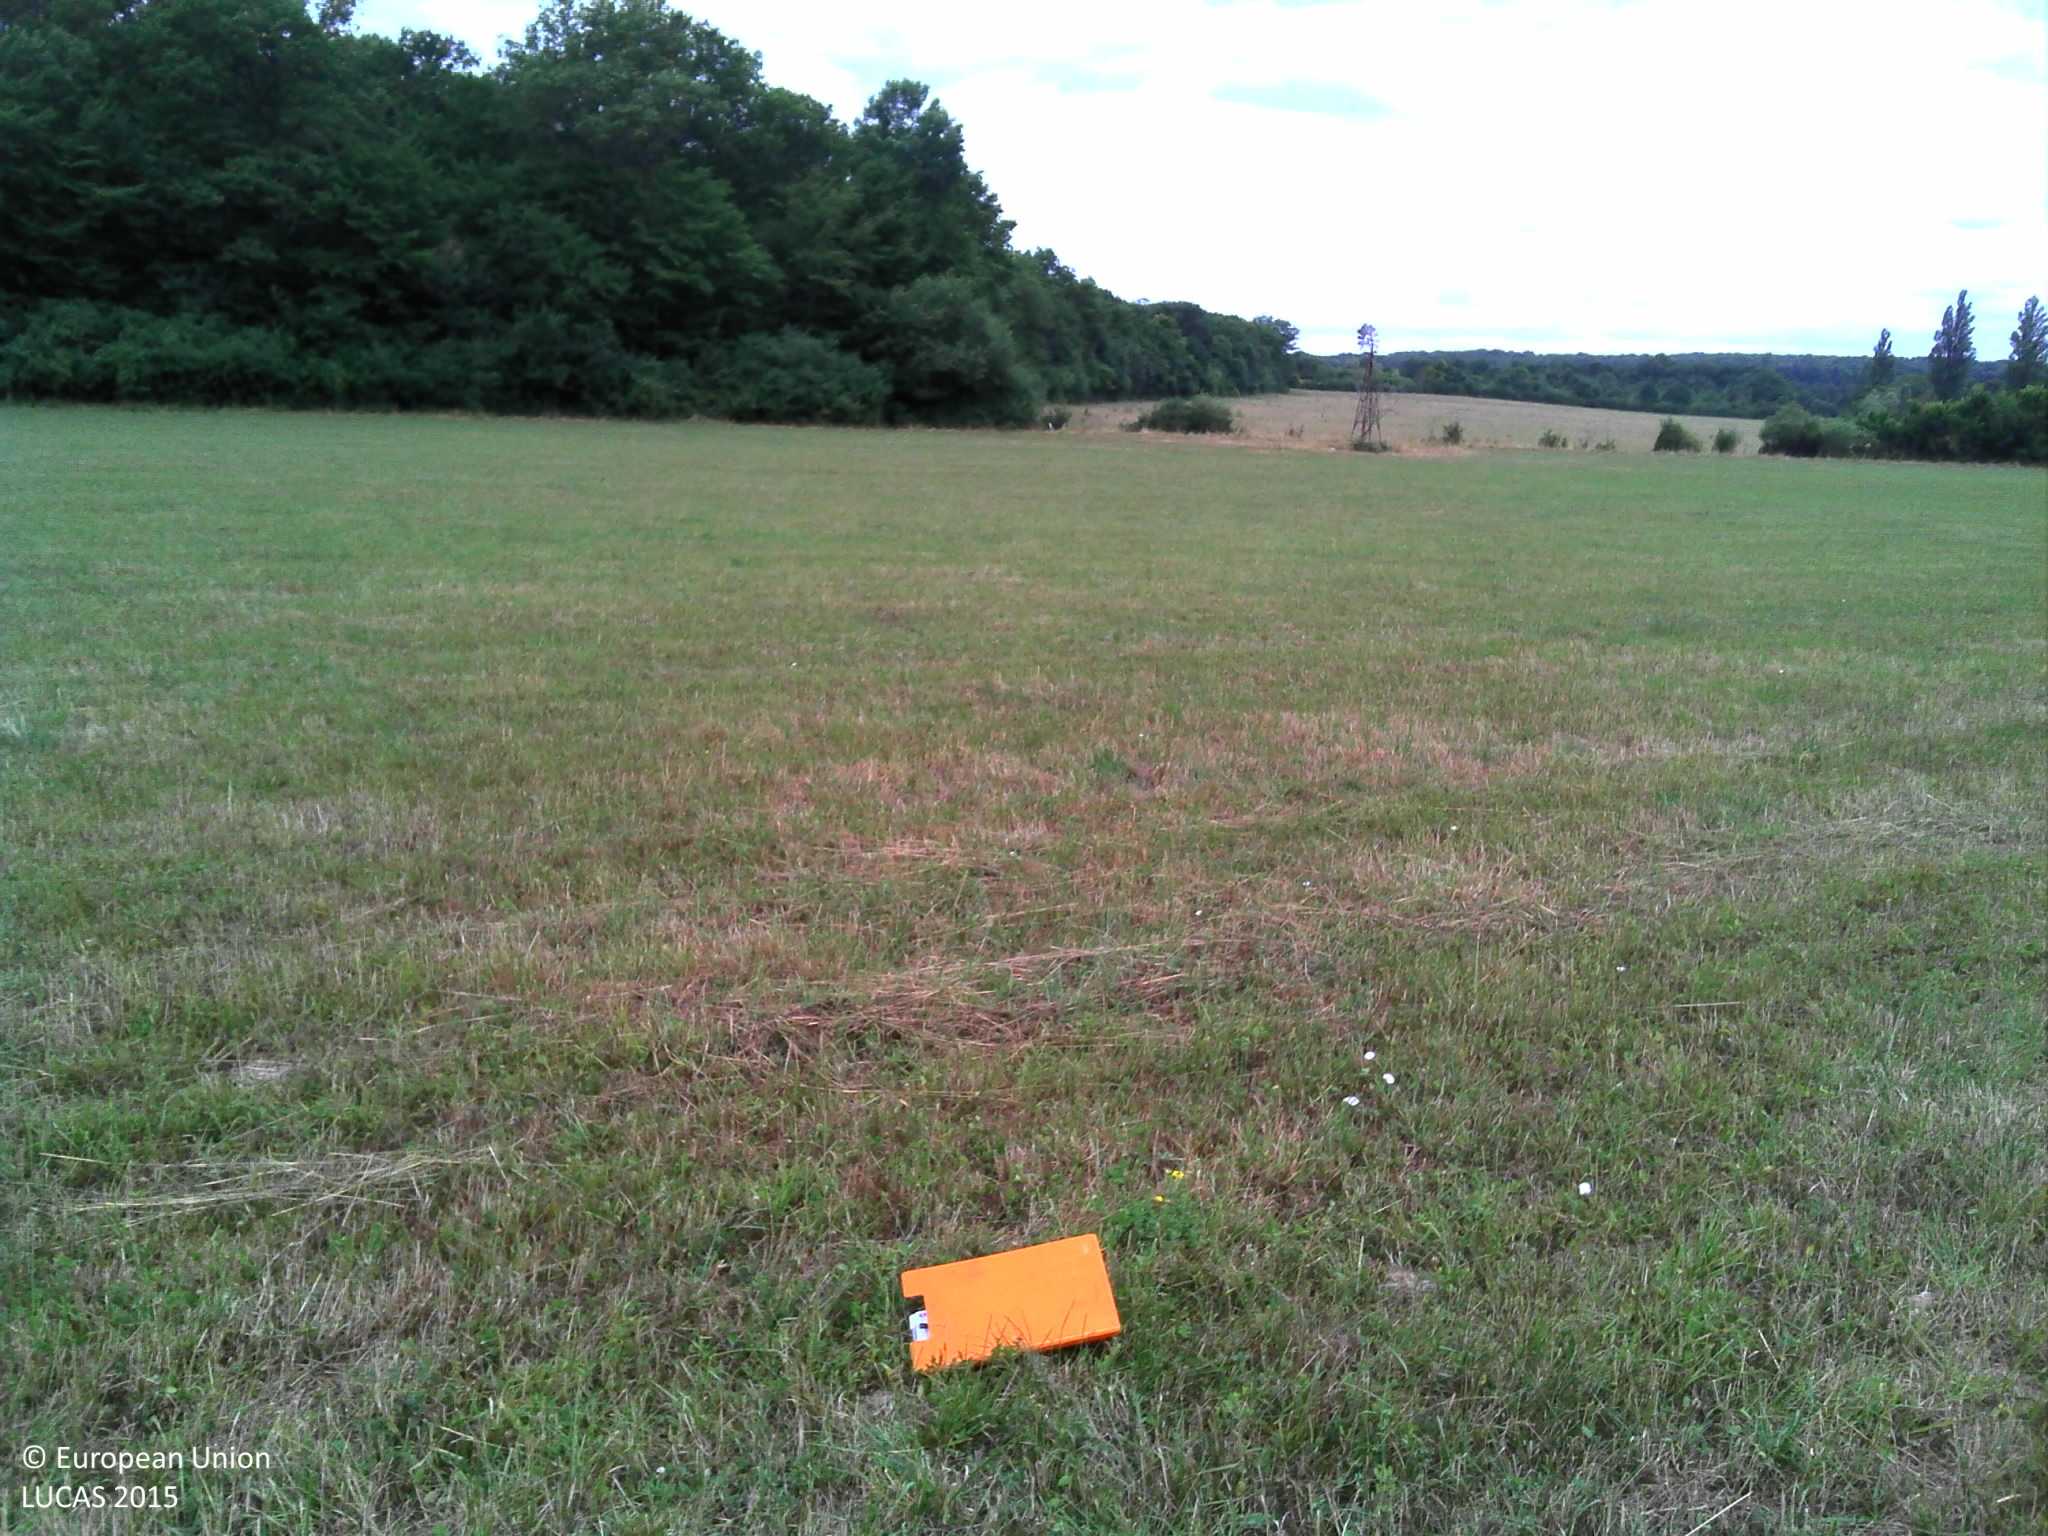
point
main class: Grassland
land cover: Grassland without tree/shrub cover
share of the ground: > 75 %
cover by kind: herbaceous plants 100 %
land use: Agriculture (excluding fallow land and kitchen gardens)
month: July
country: FR
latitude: 46.8031
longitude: 3.1964
